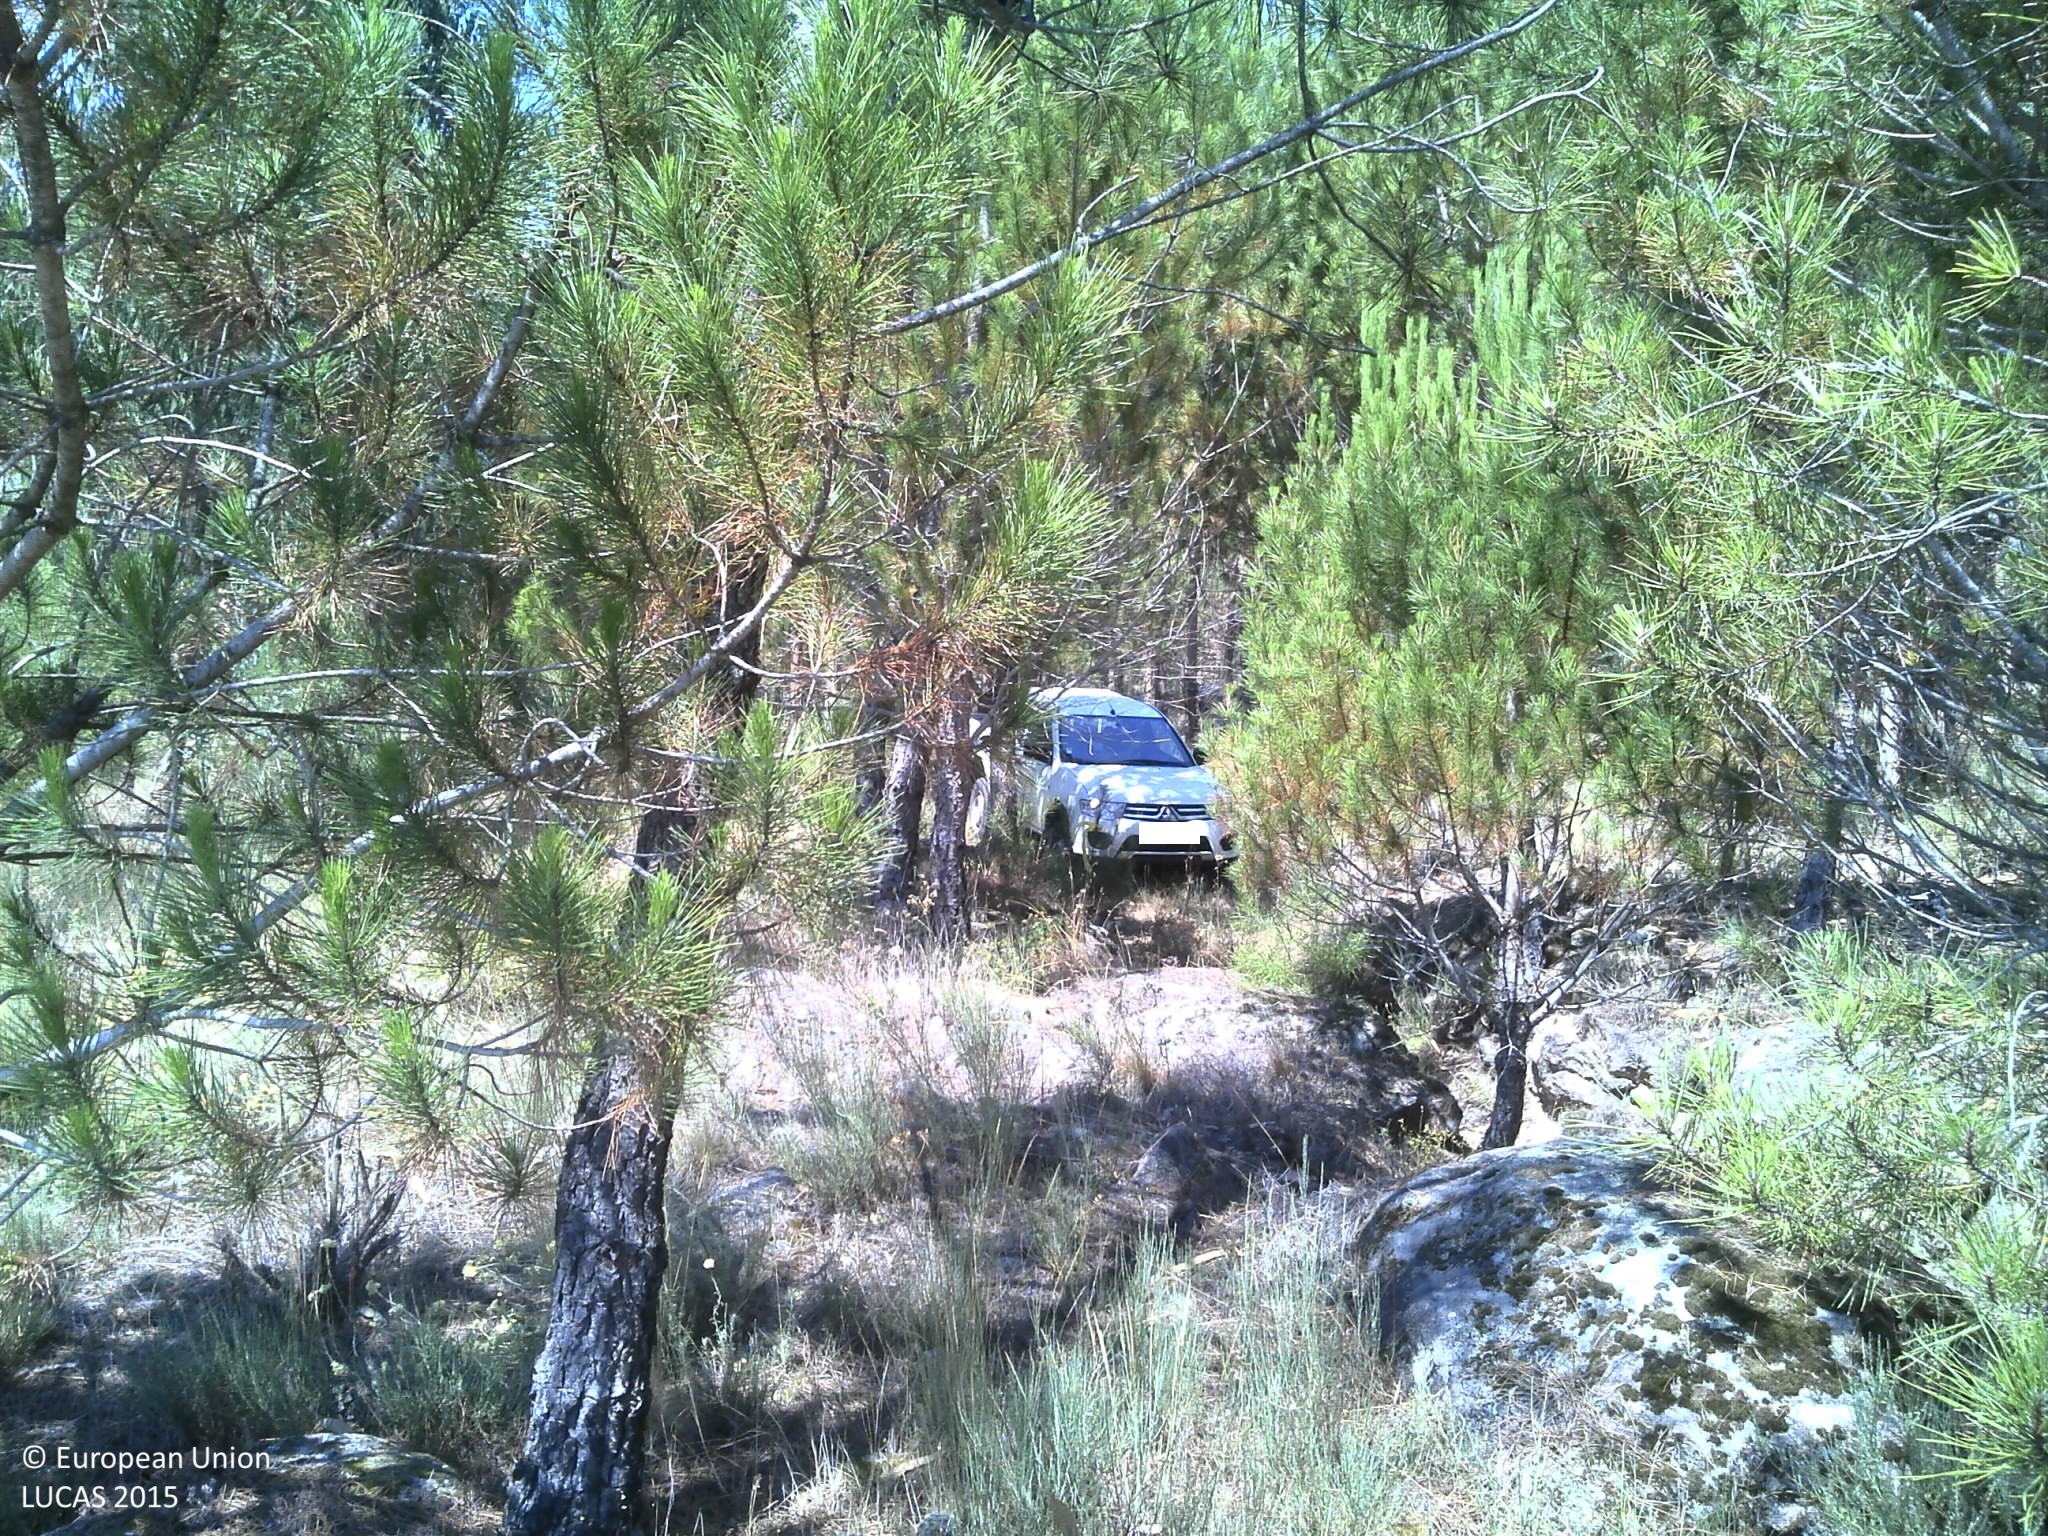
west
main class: Woodland
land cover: Pine dominated coniferous woodland
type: coniferous forest of the mediterranean region
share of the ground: 25 - 50 %
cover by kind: coniferous forest trees 45 %, herbaceous plants 25 %, shrubs 10 %, consolidated bare surface 10 %, unconsolidated bare surface 10 %
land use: Forestry
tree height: > 5 m
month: June
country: PT
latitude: 40.5329
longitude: -7.7677
